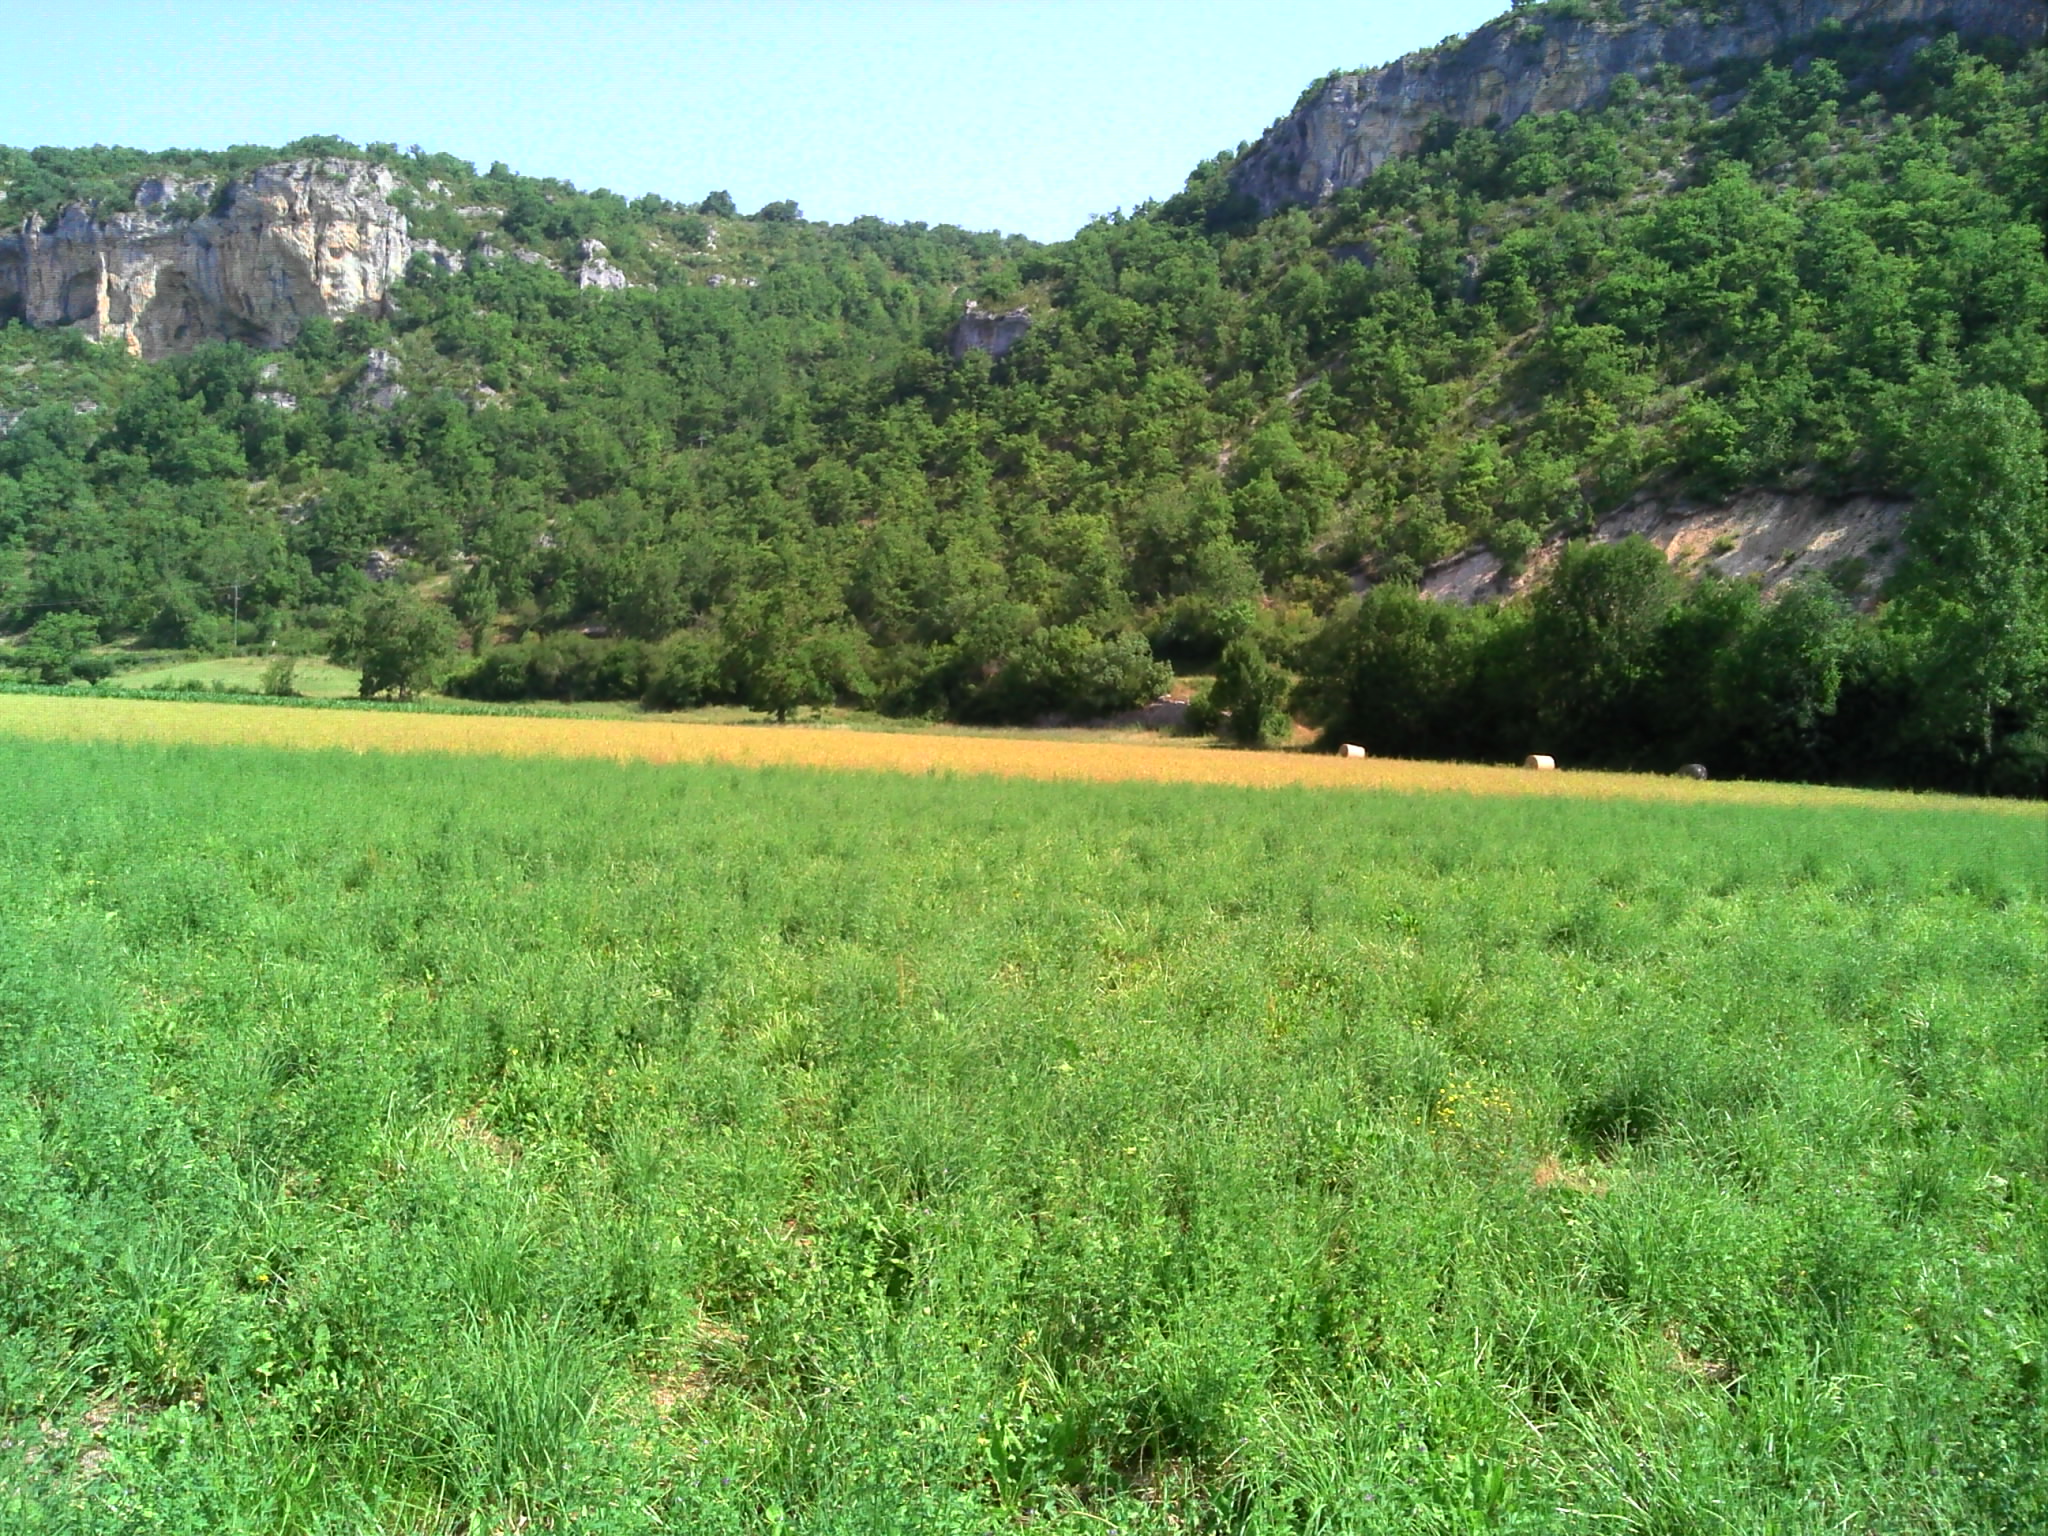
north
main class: Cropland
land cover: Lucerne
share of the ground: > 75 %
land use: Agriculture (excluding fallow land and kitchen gardens)
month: July
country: FR
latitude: 44.5694
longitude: 1.8020
